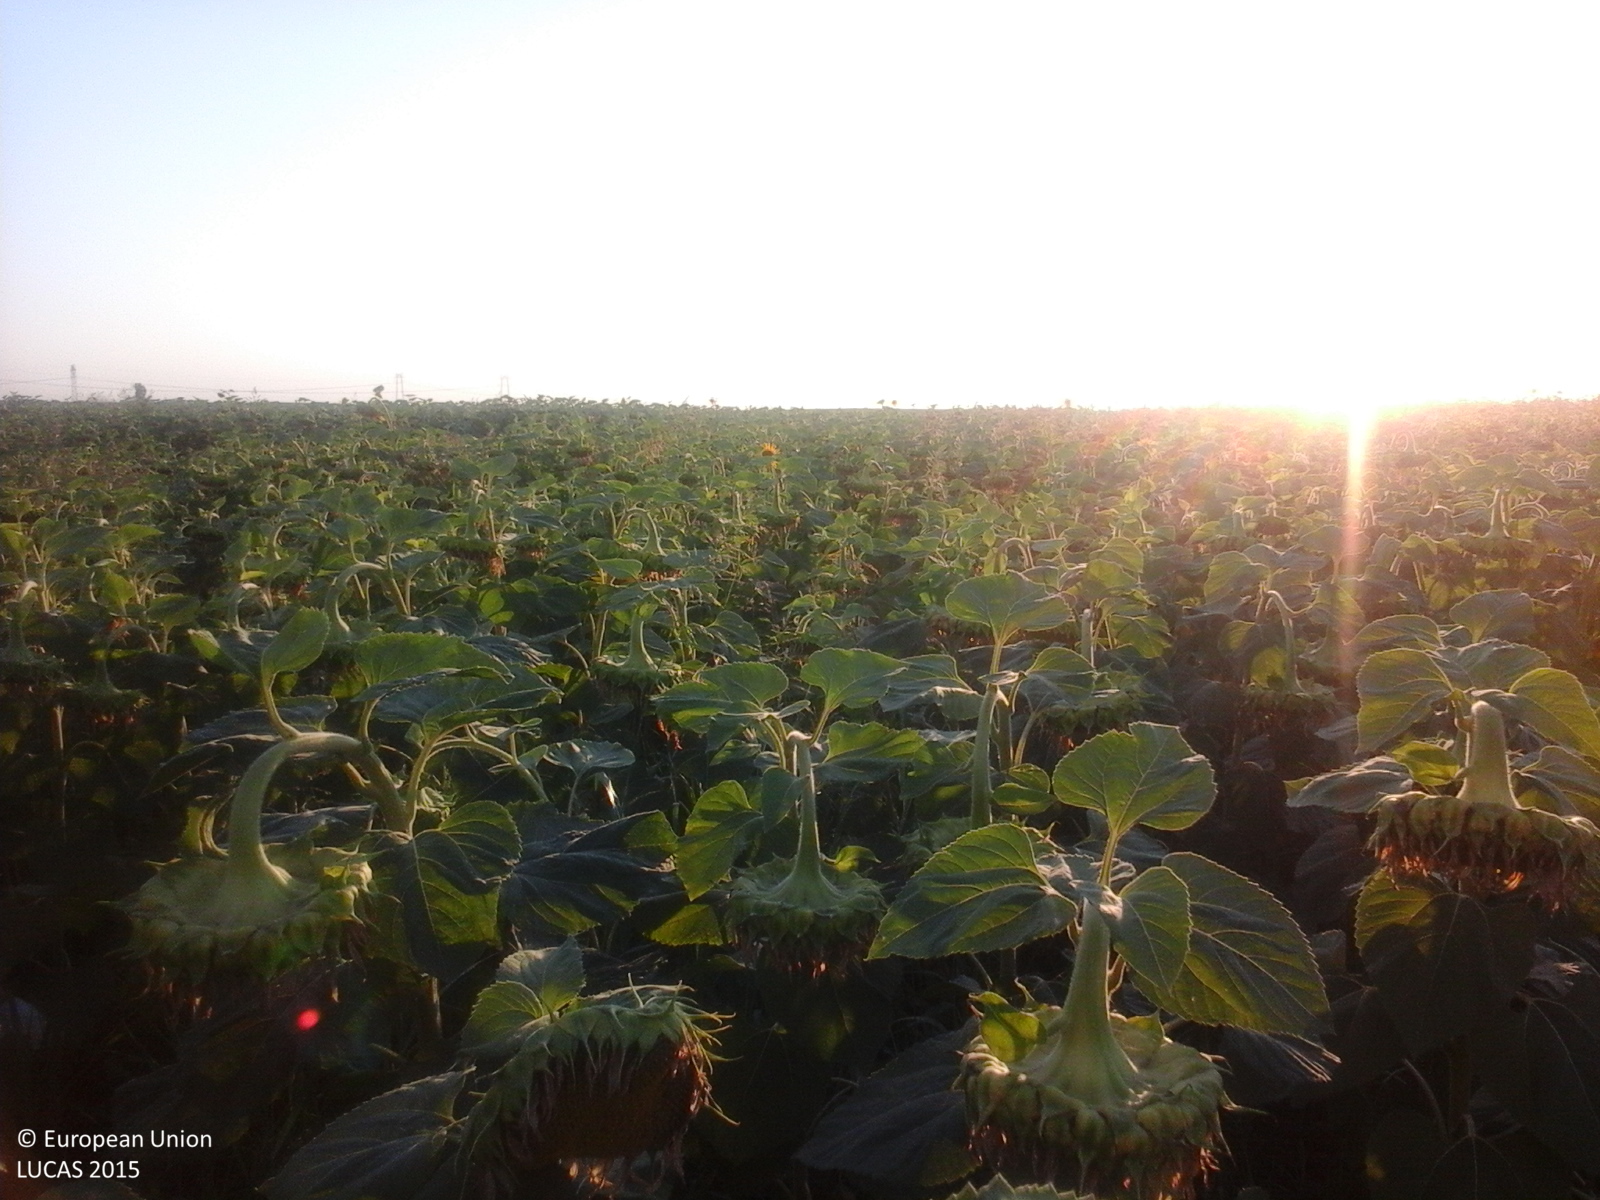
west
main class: Cropland
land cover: Sunflower
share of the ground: > 75 %
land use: Agriculture (excluding fallow land and kitchen gardens)
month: July
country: RO
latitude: 44.4757
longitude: 27.7894
